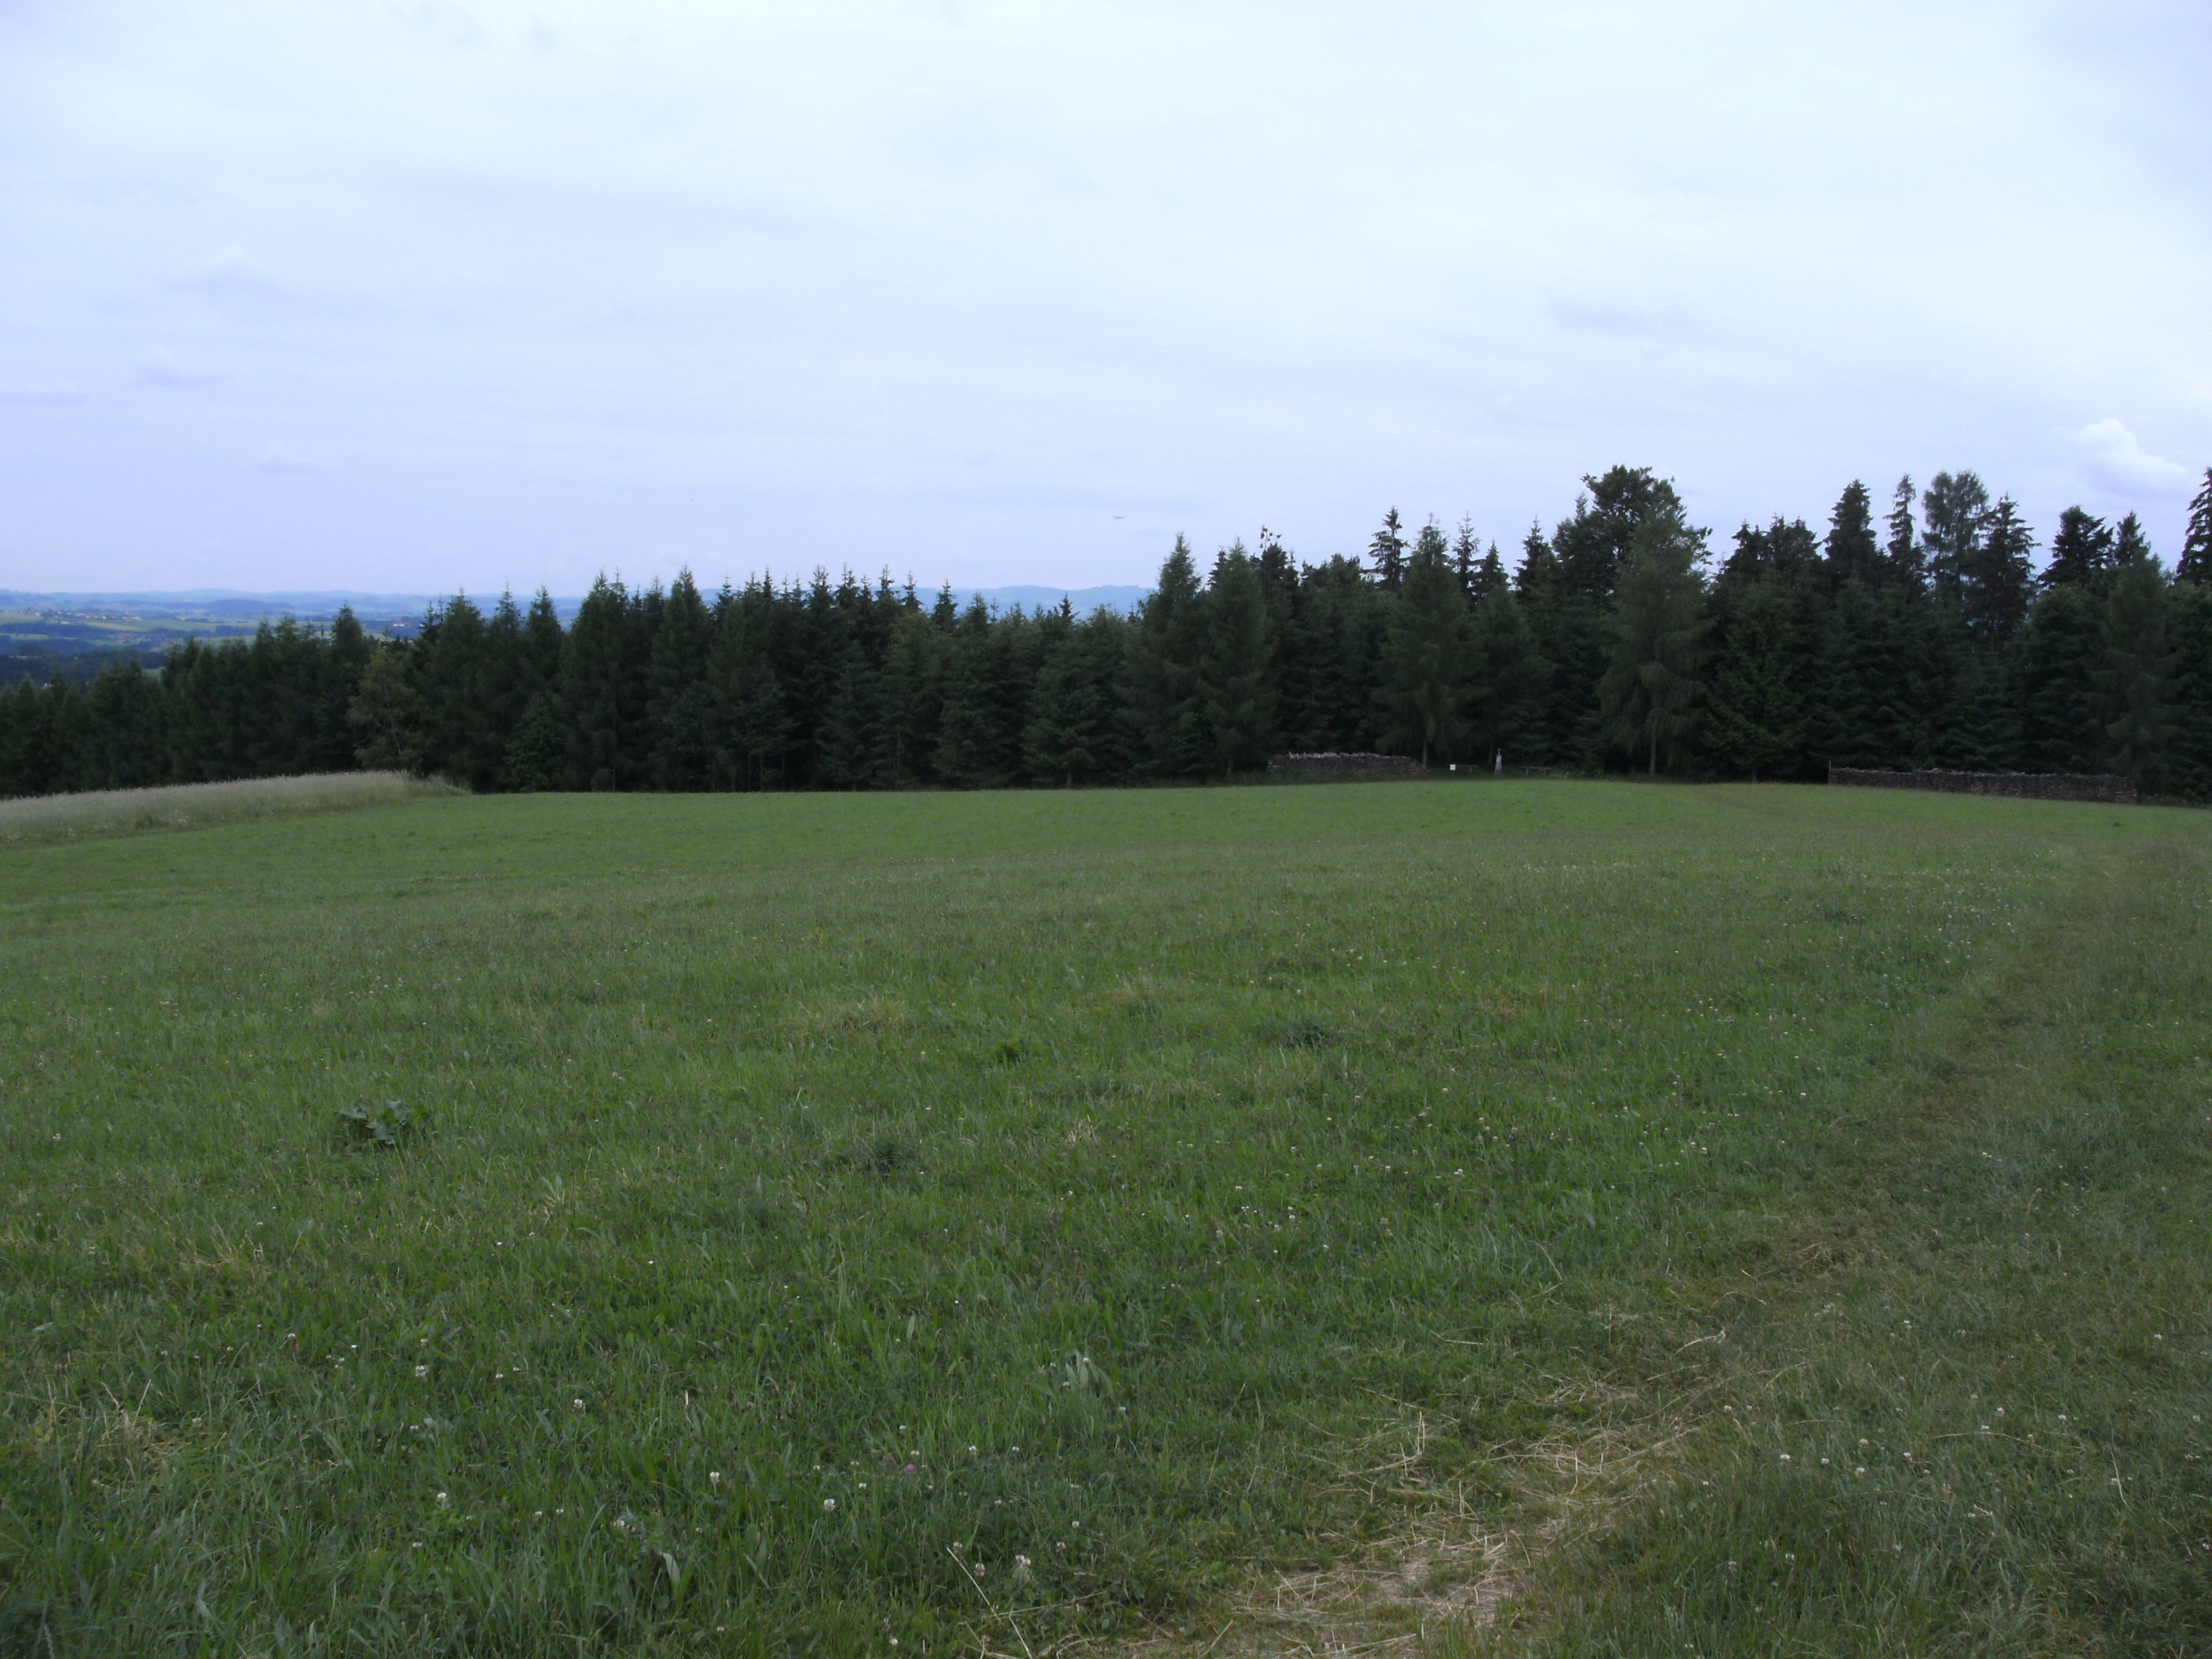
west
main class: Grassland
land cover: Grassland without tree/shrub cover
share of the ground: > 75 %
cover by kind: herbaceous plants 100 %
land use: Agriculture (excluding fallow land and kitchen gardens)
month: June
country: AT
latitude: 48.4886
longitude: 14.1270
